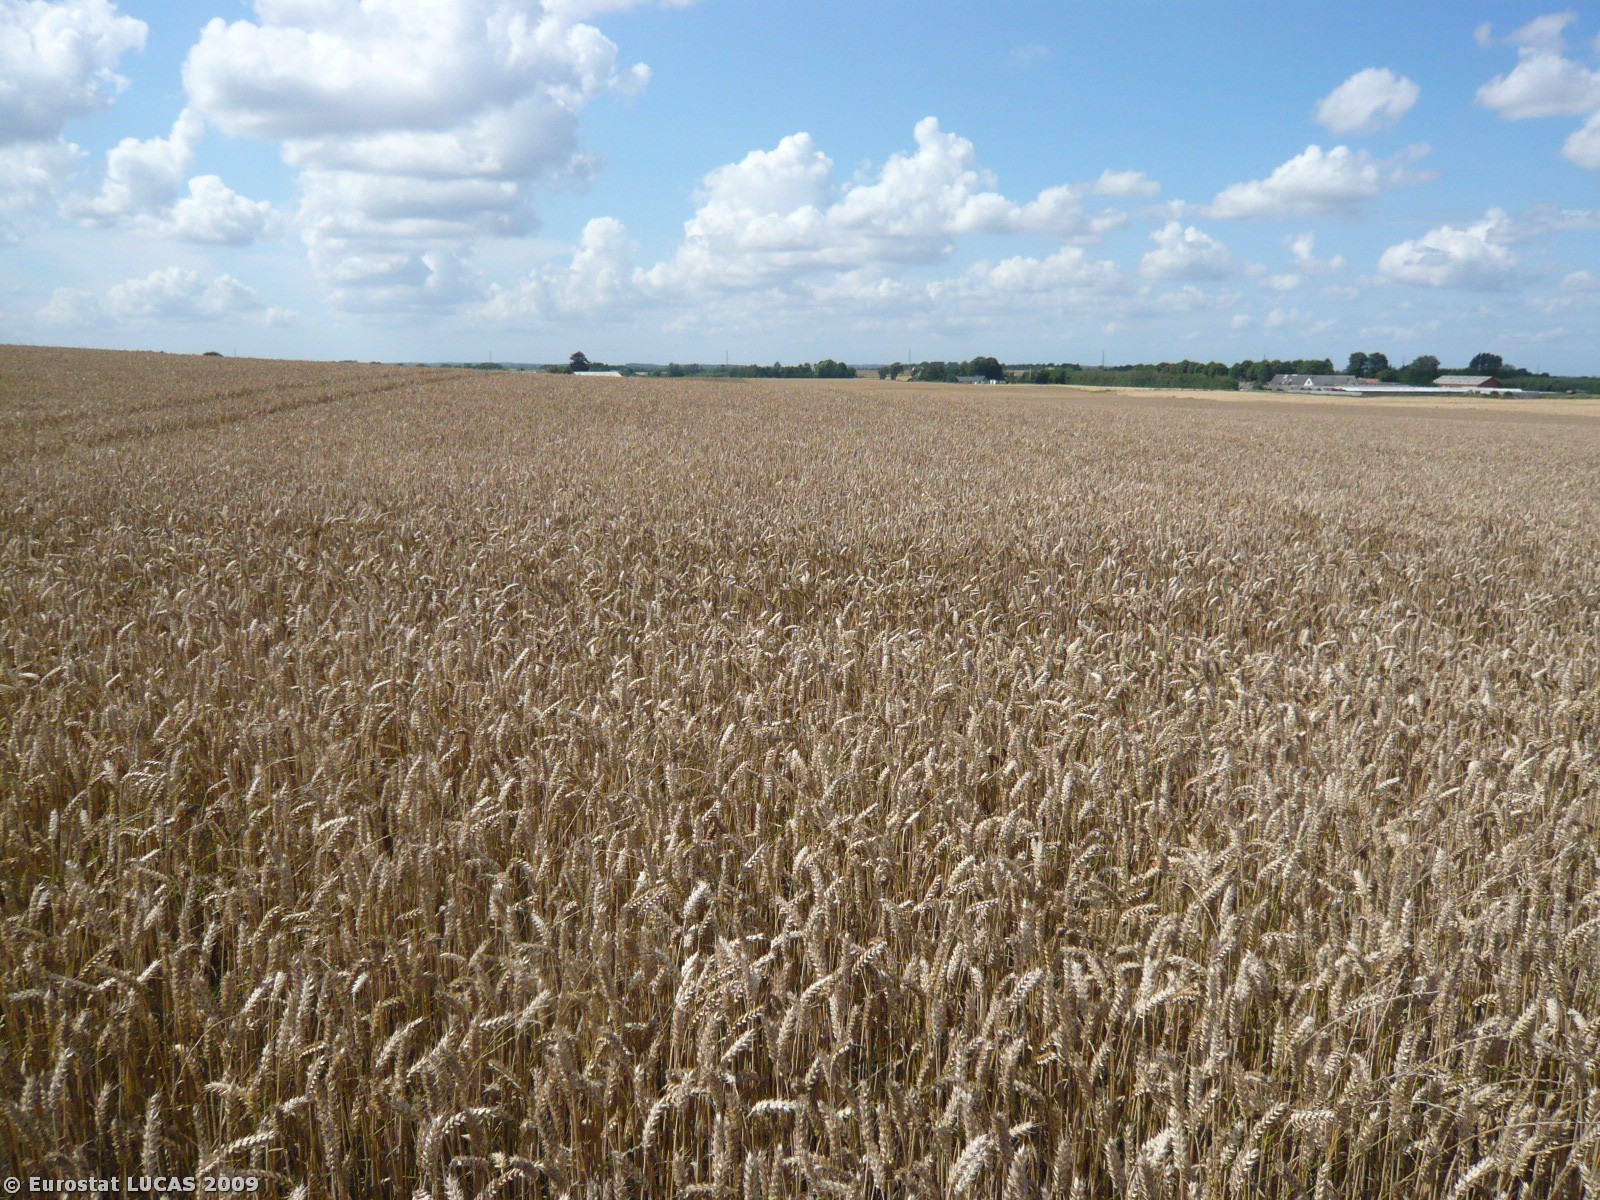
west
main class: Cropland
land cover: Common wheat
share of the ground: > 75 %
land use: Agriculture (excluding fallow land and kitchen gardens)
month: July
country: DK
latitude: 55.5596
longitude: 12.0753
